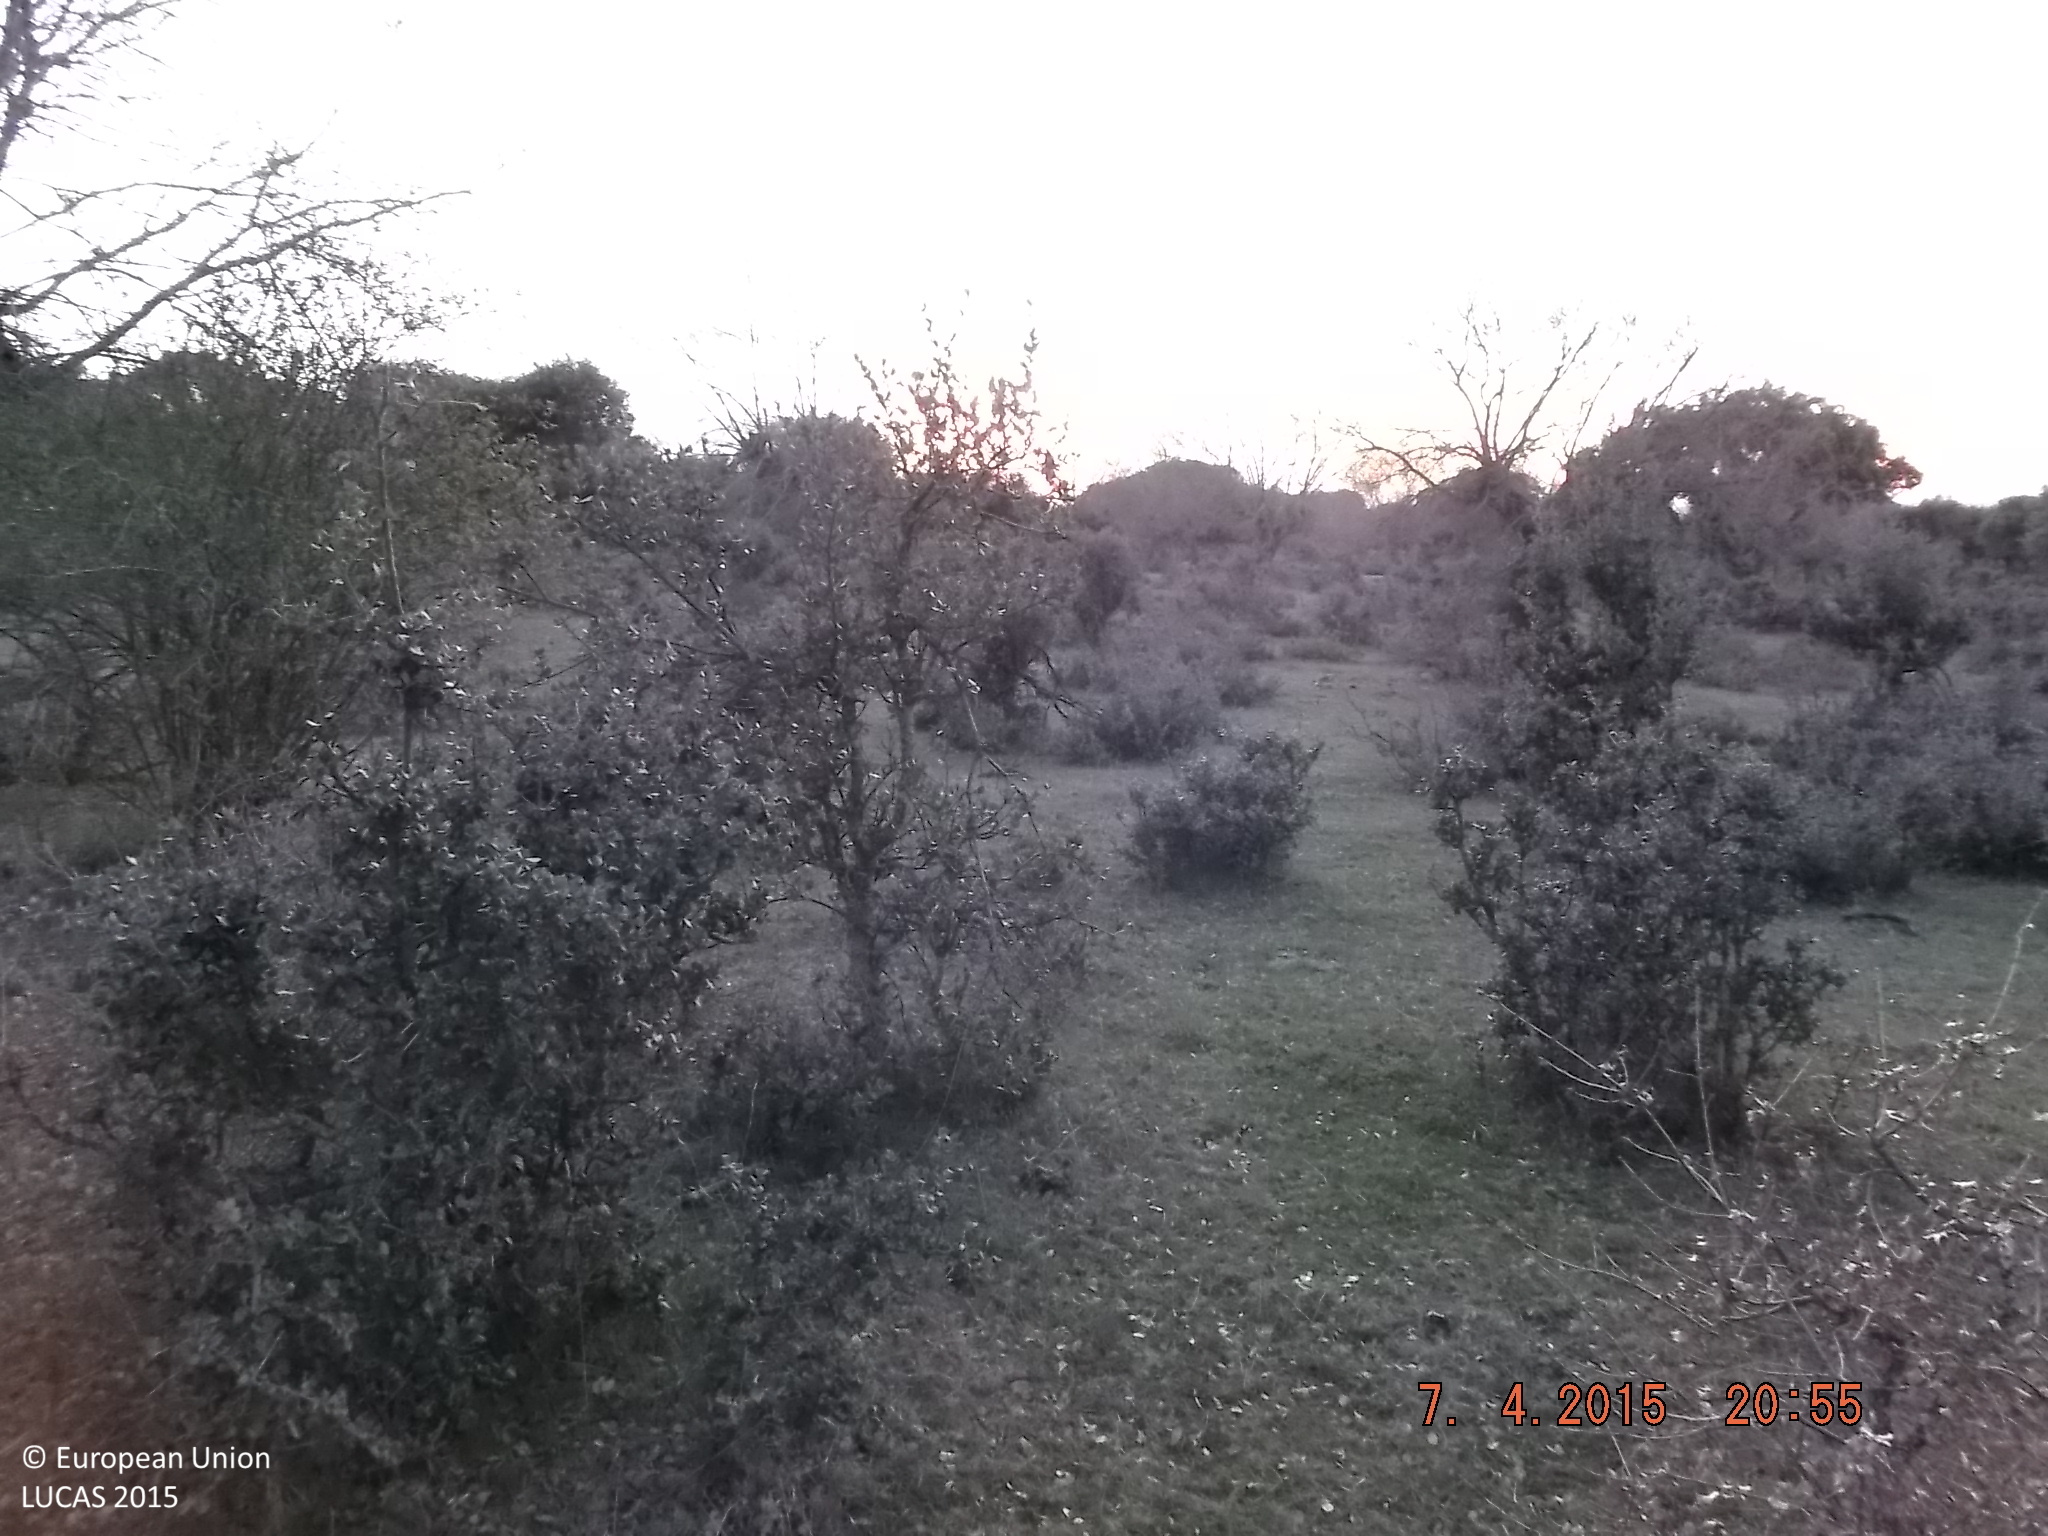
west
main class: Woodland
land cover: Broadleaved woodland
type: broadleaved evergreen forest
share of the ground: 25 - 50 %
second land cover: Shrubland without tree cover
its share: 50 - 75 %
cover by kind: shrubs 50 %, broadleaved forest trees 40 %, herbaceous plants 10 %
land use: Forestry
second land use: Agriculture (excluding fallow land and kitchen gardens)
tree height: < 5 m
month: April
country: ES
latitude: 40.8253
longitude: -5.8611
